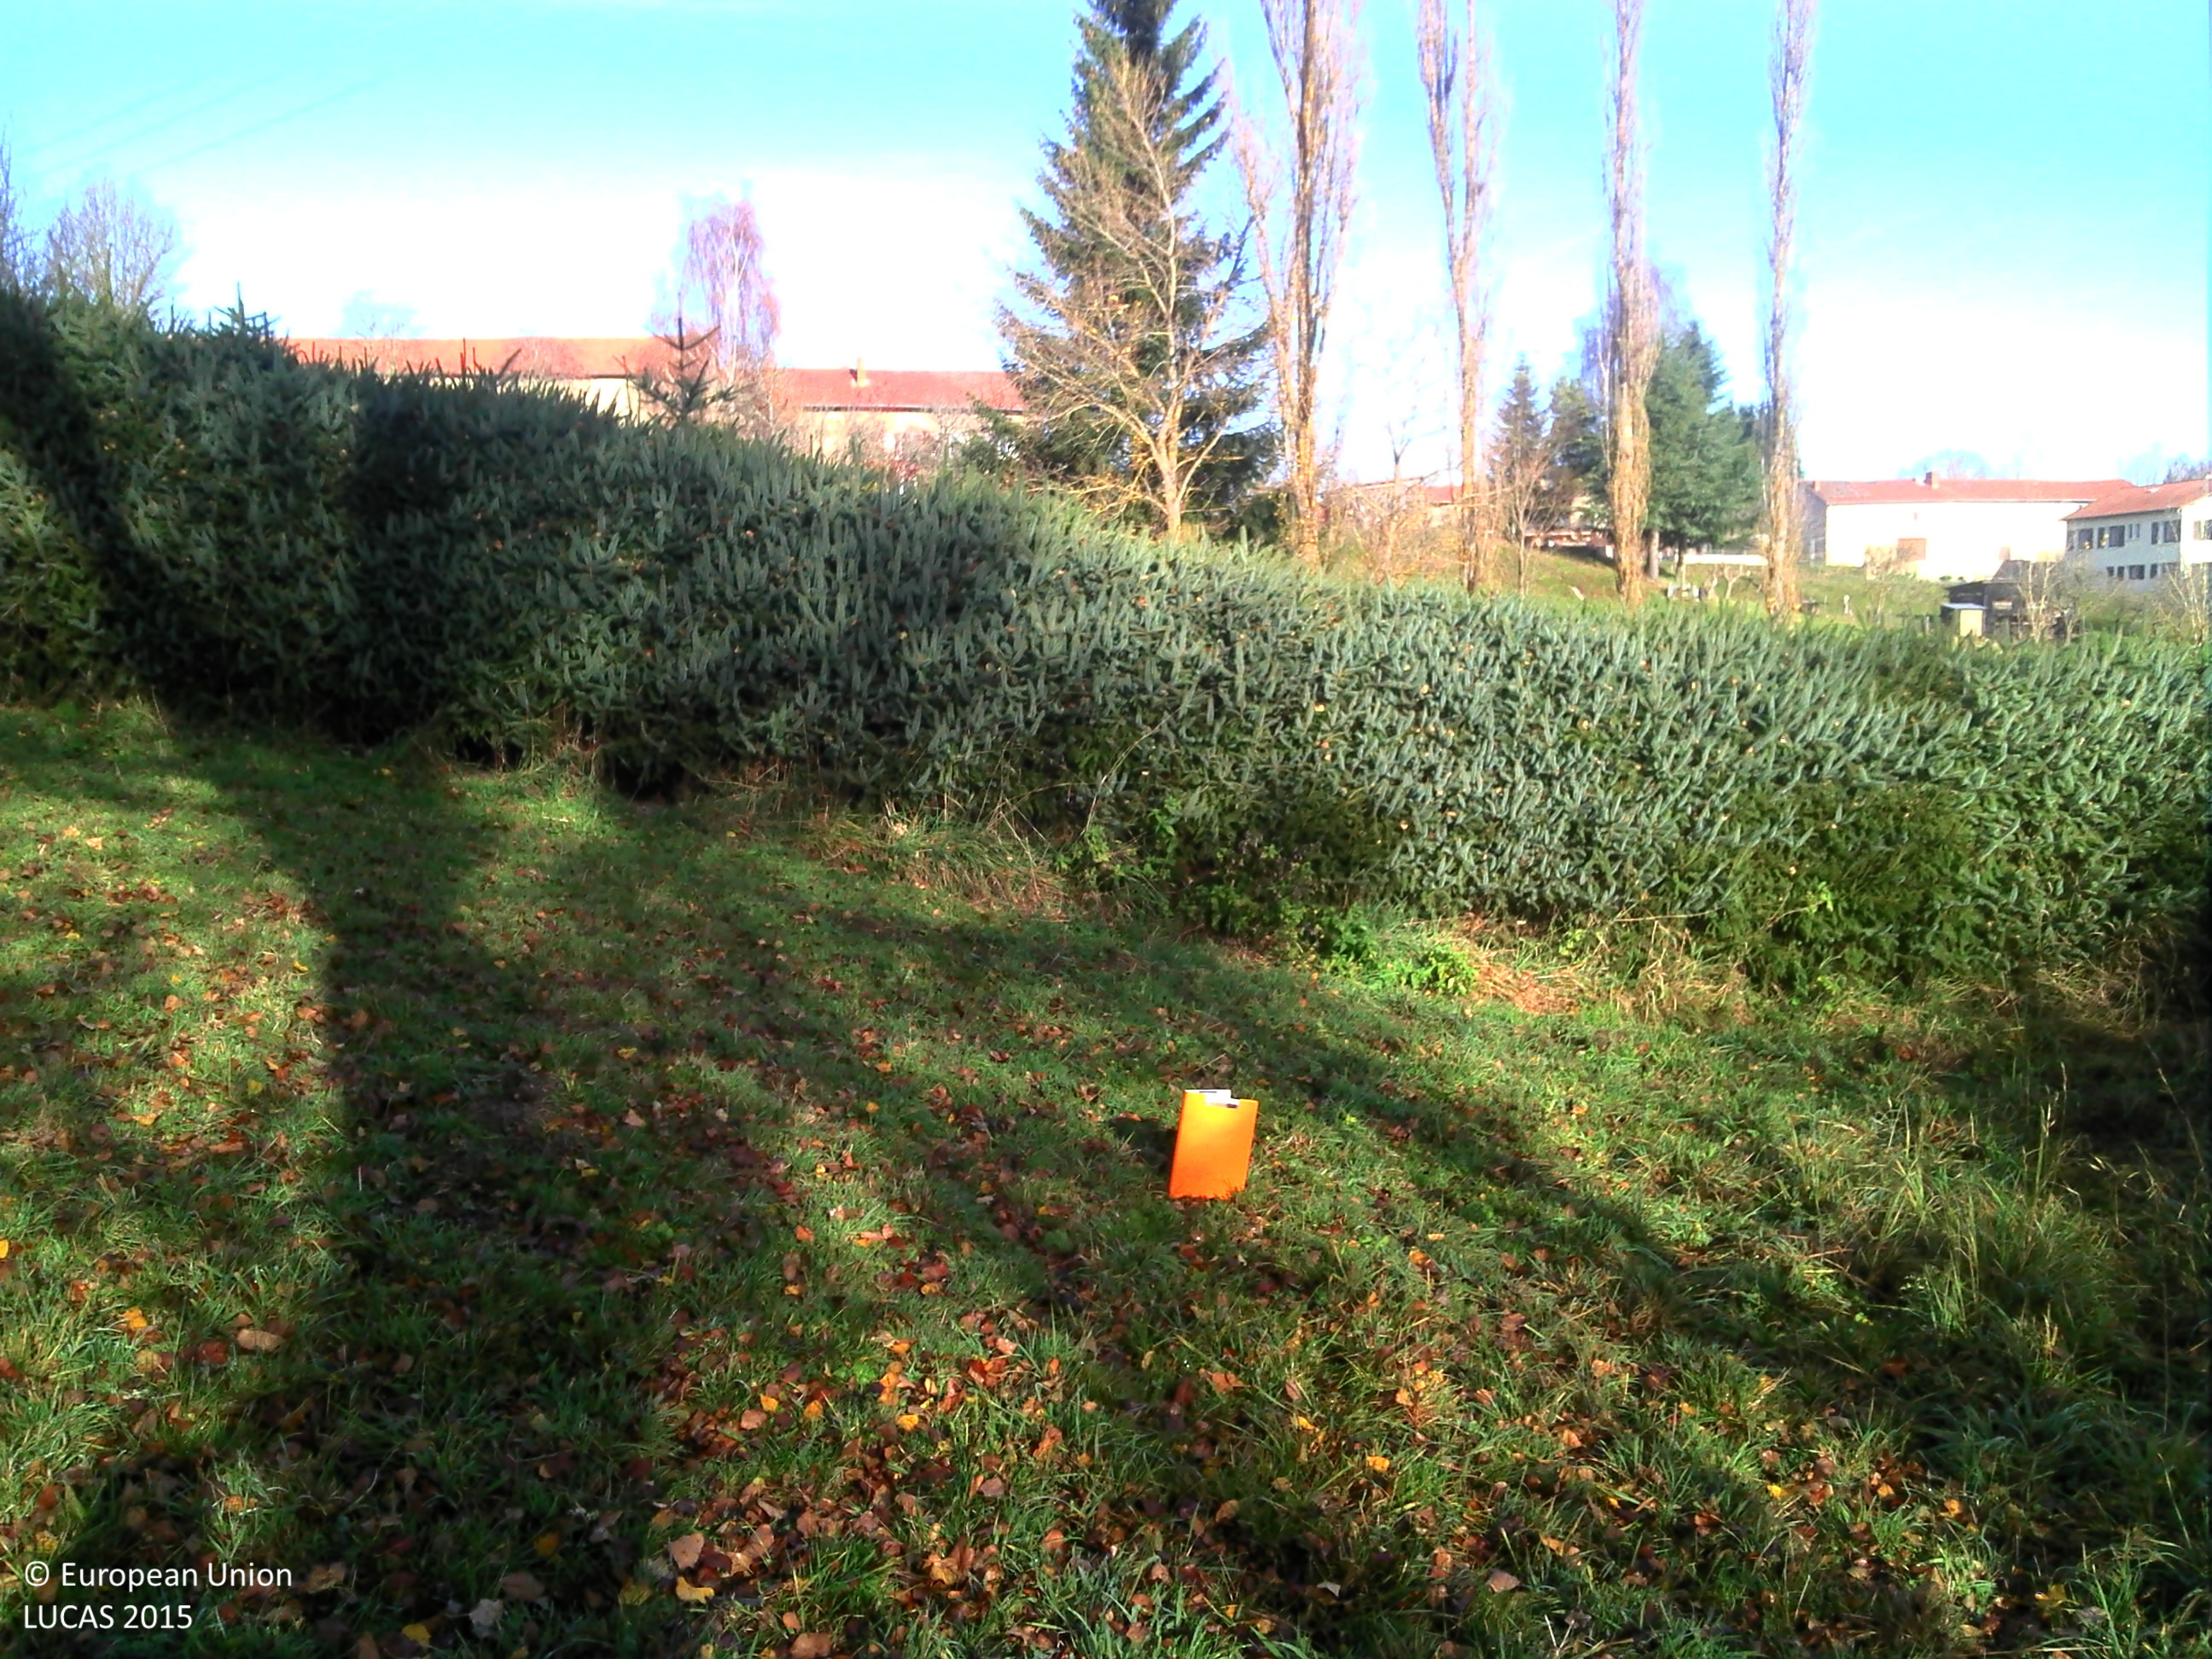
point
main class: Grassland
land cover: Grassland without tree/shrub cover
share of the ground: > 75 %
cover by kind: herbaceous plants 100 %
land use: Agriculture (excluding fallow land and kitchen gardens)
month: November
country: FR
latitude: 45.3246
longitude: 3.8410
